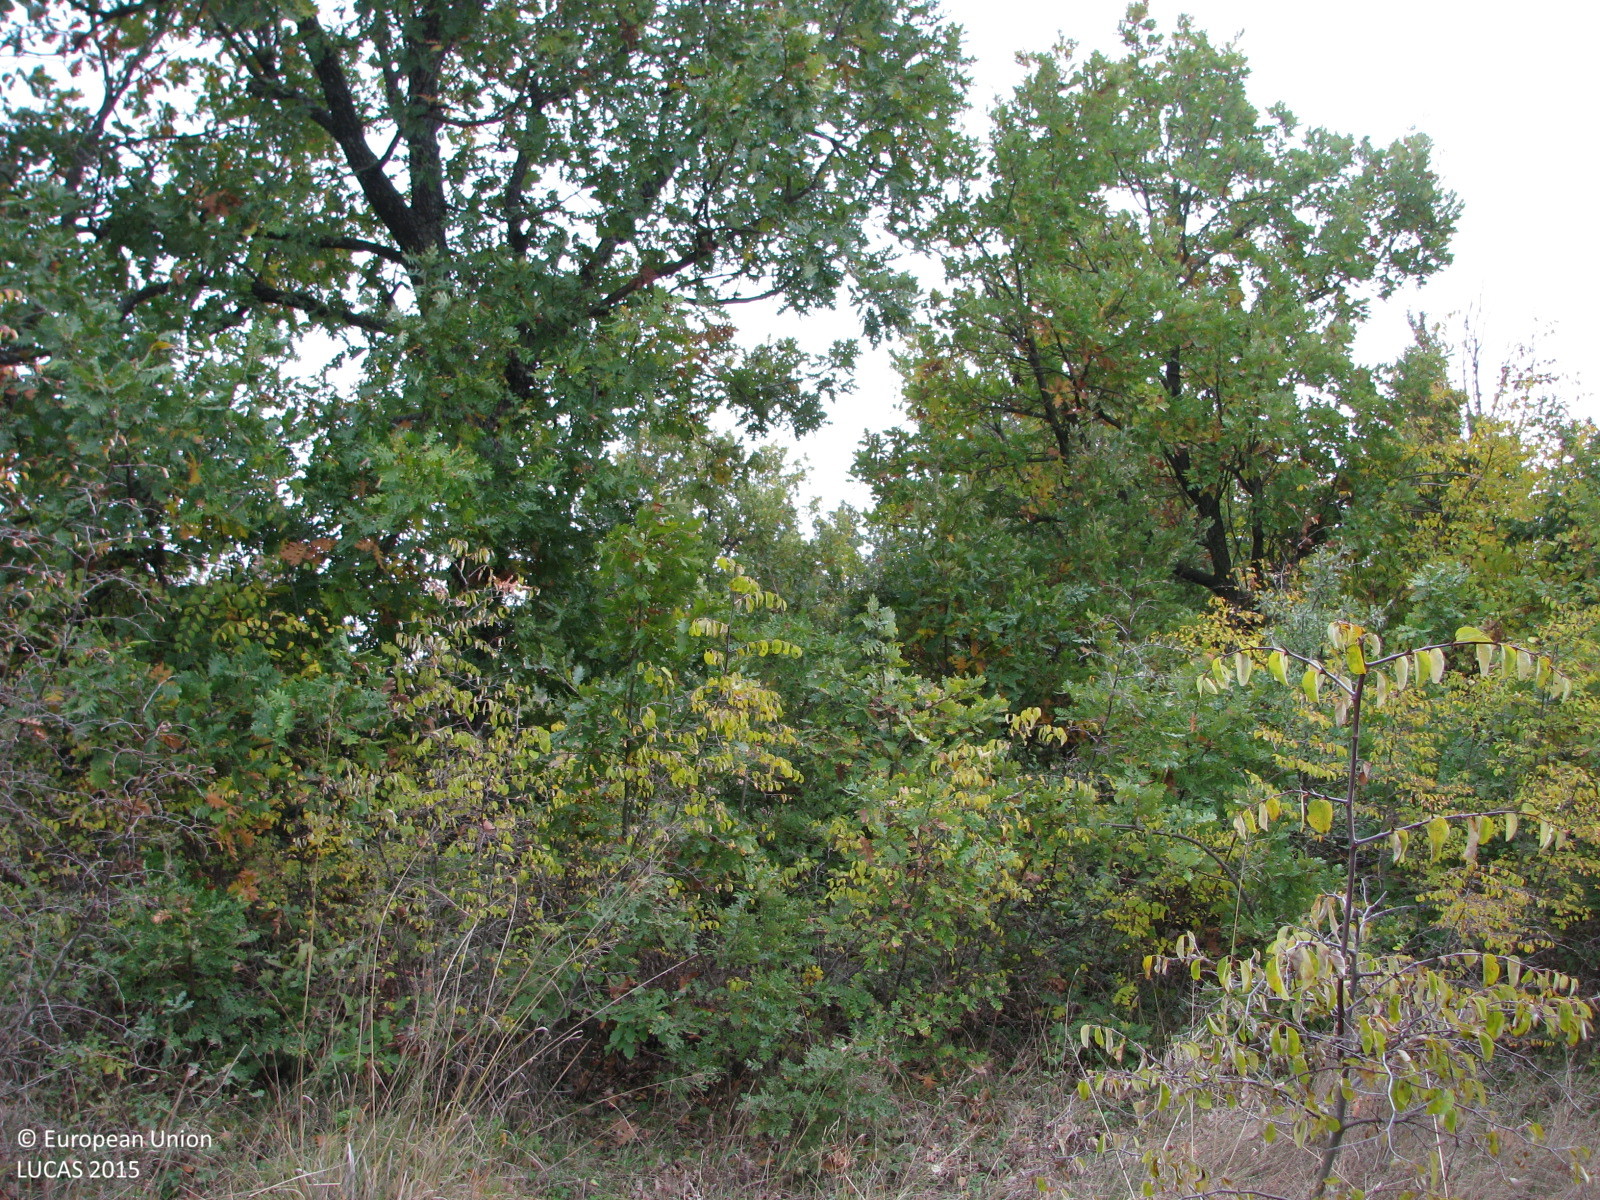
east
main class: Shrubland
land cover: Shrubland with sparse tree cover
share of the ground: 25 - 50 %
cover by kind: herbaceous plants 60 %, shrubs 35 %, broadleaved forest trees 5 %
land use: Semi-natural and natural areas not in use
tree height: < 5 m
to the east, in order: Shrubland with sparse tree cover; Grassland with sparse tree/shrub cover; Shrubland with sparse tree cover; Grassland with sparse tree/shrub cover; Shrubland with sparse tree cover; Electric lines; Shrubland with sparse tree cover; Grassland without tree/shrub cover
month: October
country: BG
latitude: 41.9572
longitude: 26.5794
